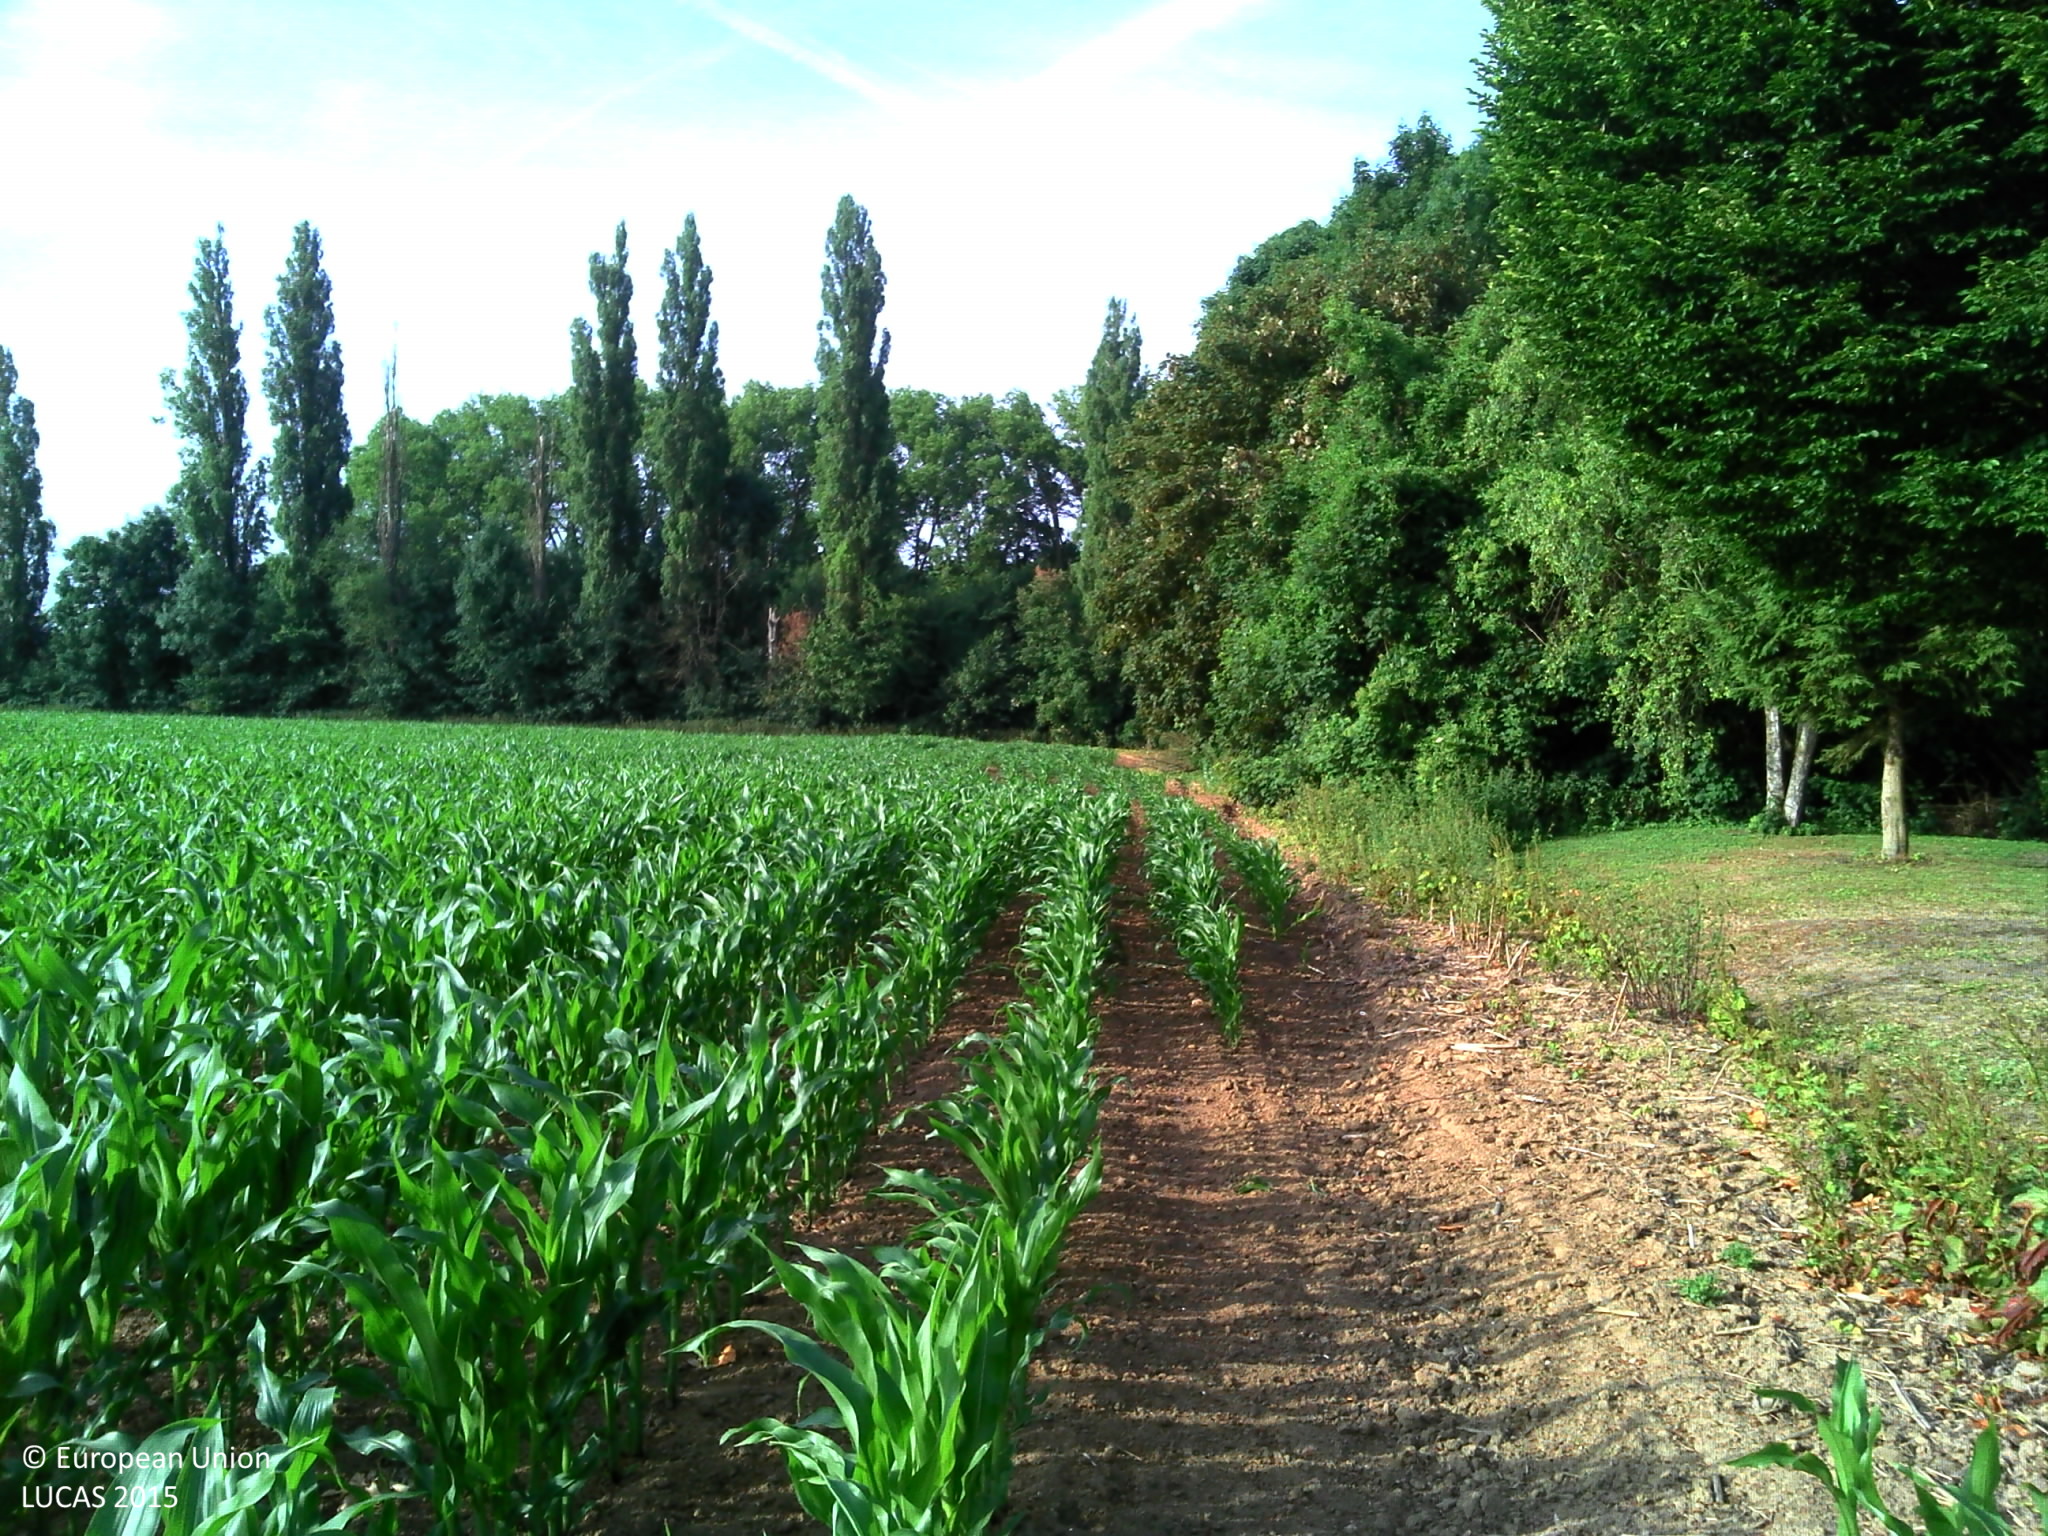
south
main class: Cropland
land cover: Maize
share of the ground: 50 - 75 %
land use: Agriculture (excluding fallow land and kitchen gardens)
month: June
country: FR
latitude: 49.3850
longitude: 2.6188
